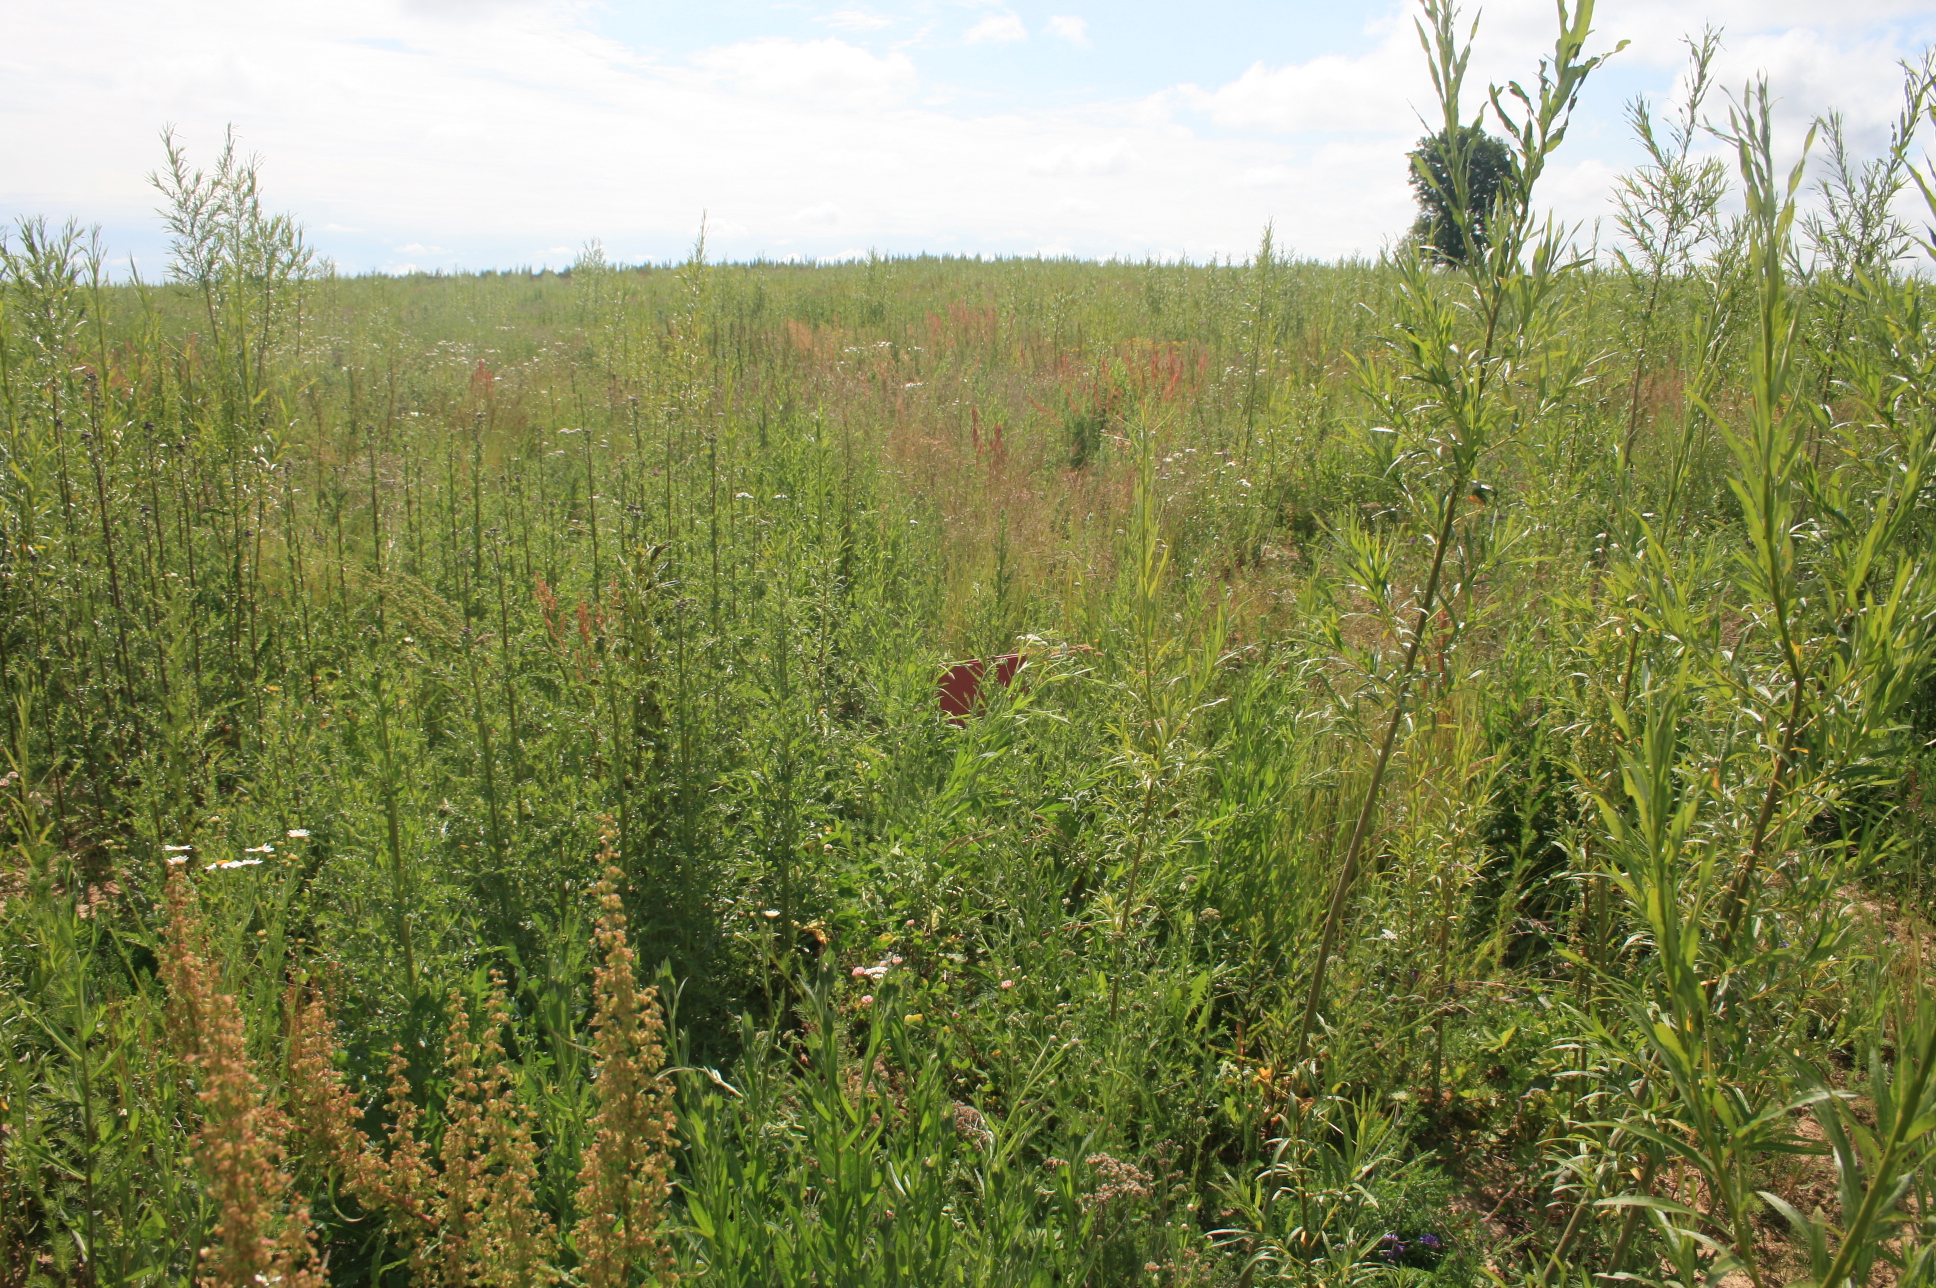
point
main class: Shrubland
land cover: Shrubland without tree cover
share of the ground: 50 - 75 %
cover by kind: shrubs 60 %, herbaceous plants 40 %
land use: Abandoned areas
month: June
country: LT
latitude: 55.2496
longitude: 22.0894
